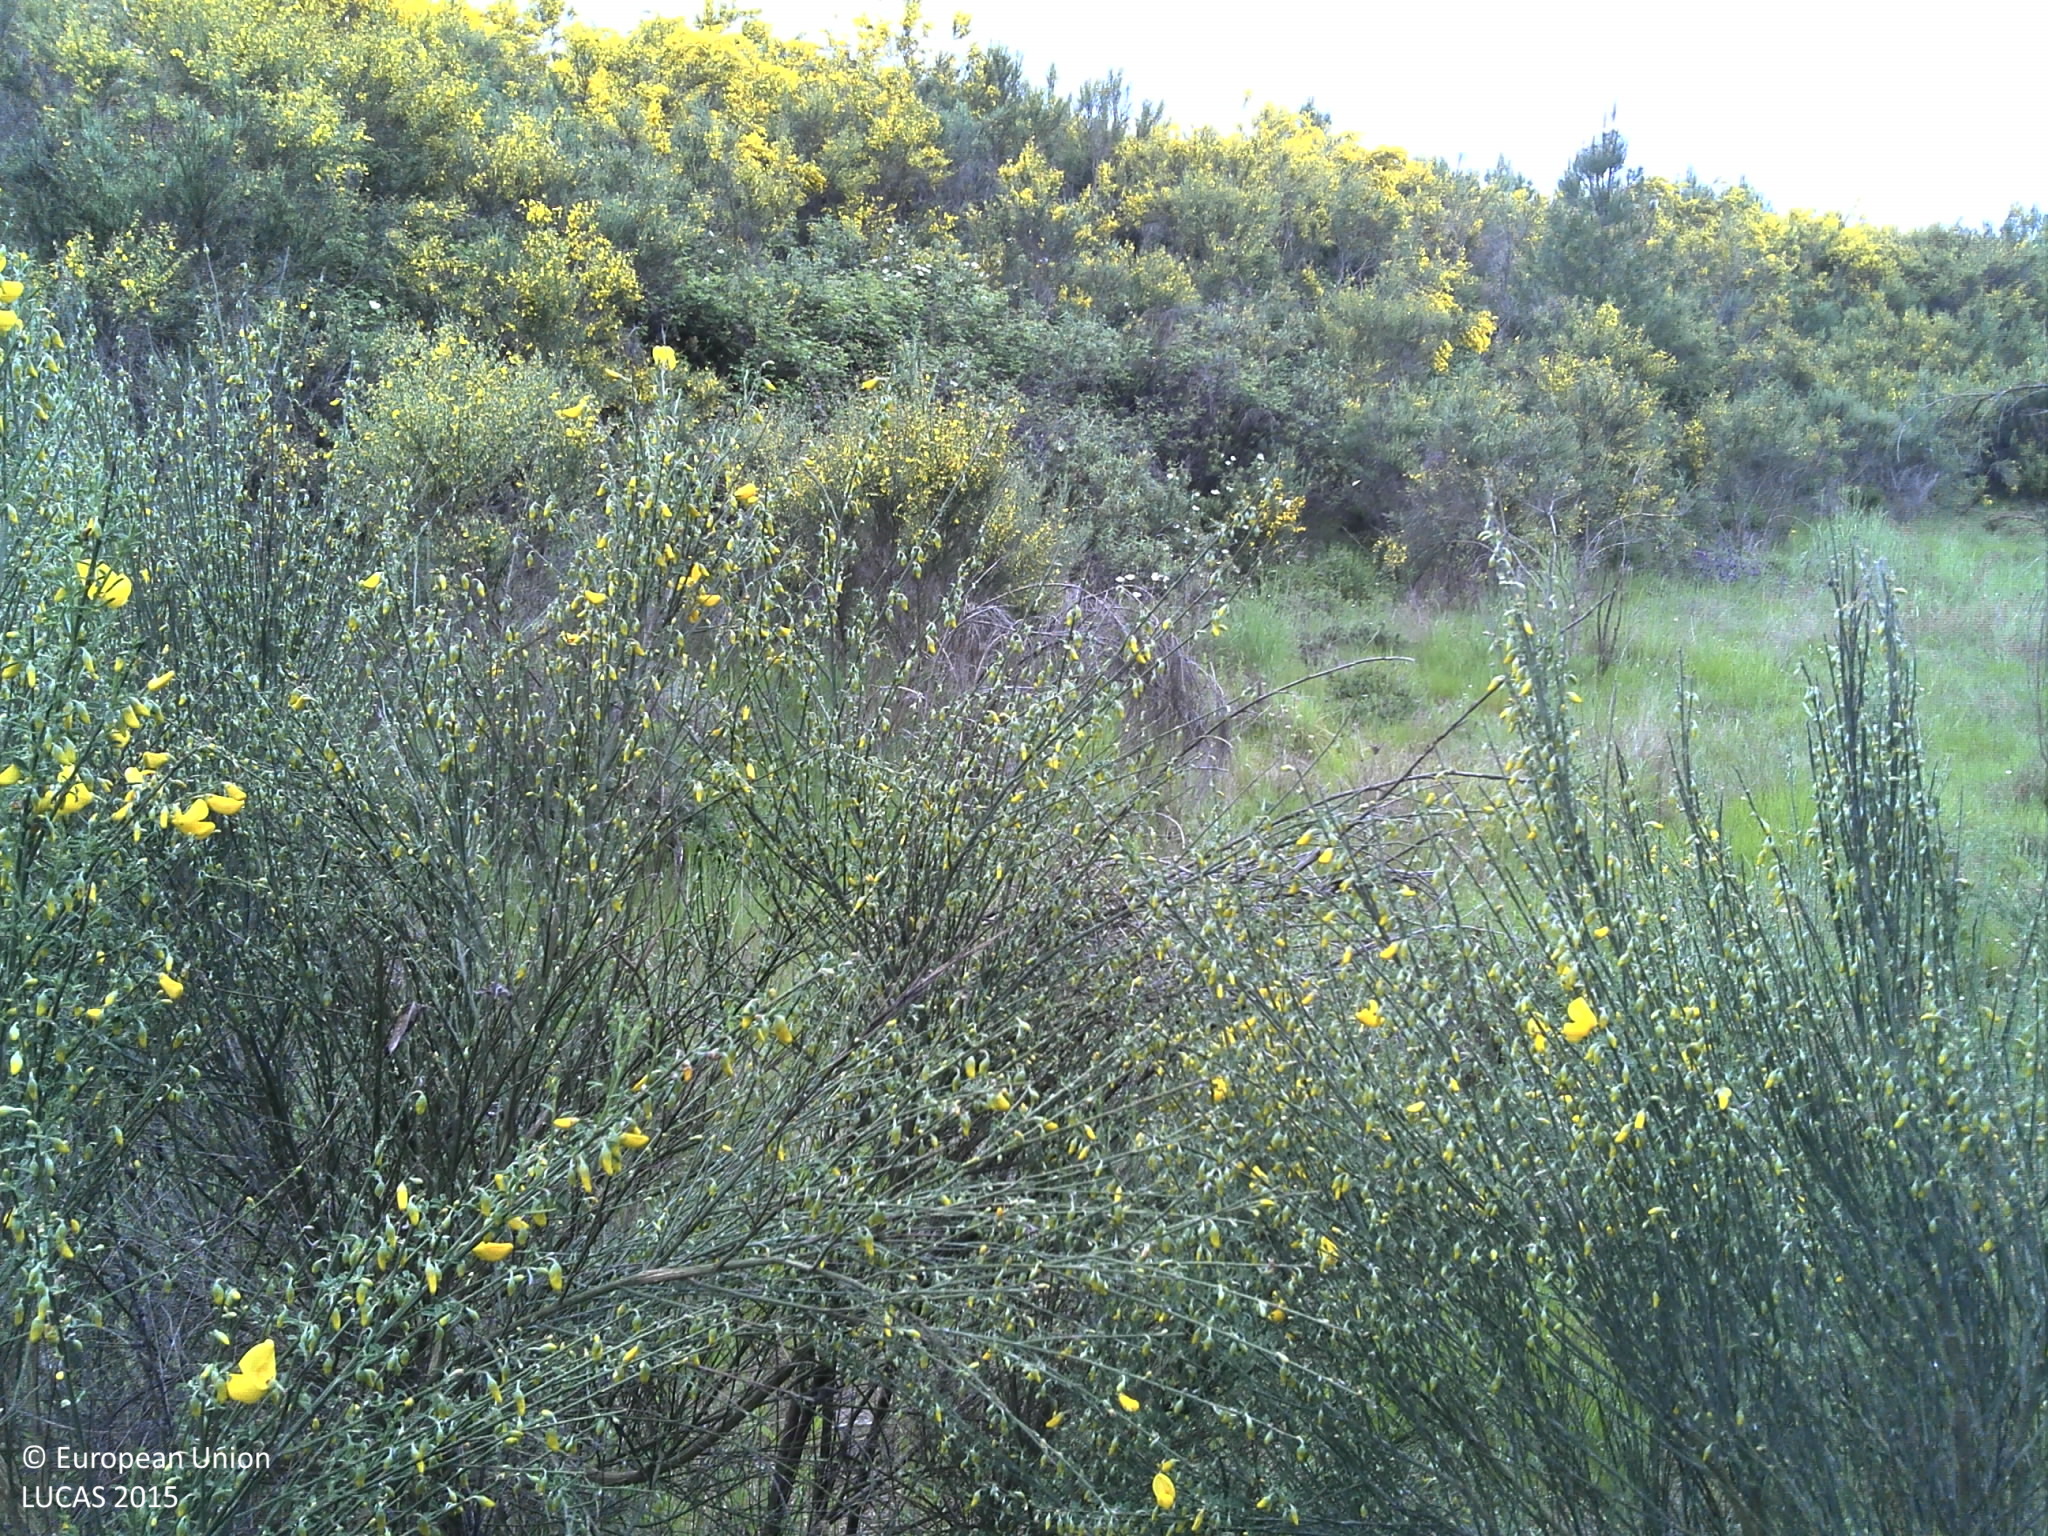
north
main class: Shrubland
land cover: Shrubland with sparse tree cover
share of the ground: > 75 %
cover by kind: shrubs 70 %, herbaceous plants 25 %, coniferous forest trees 5 %
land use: Semi-natural and natural areas not in use
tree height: > 5 m
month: May
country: PT
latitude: 41.7731
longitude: -7.1202
